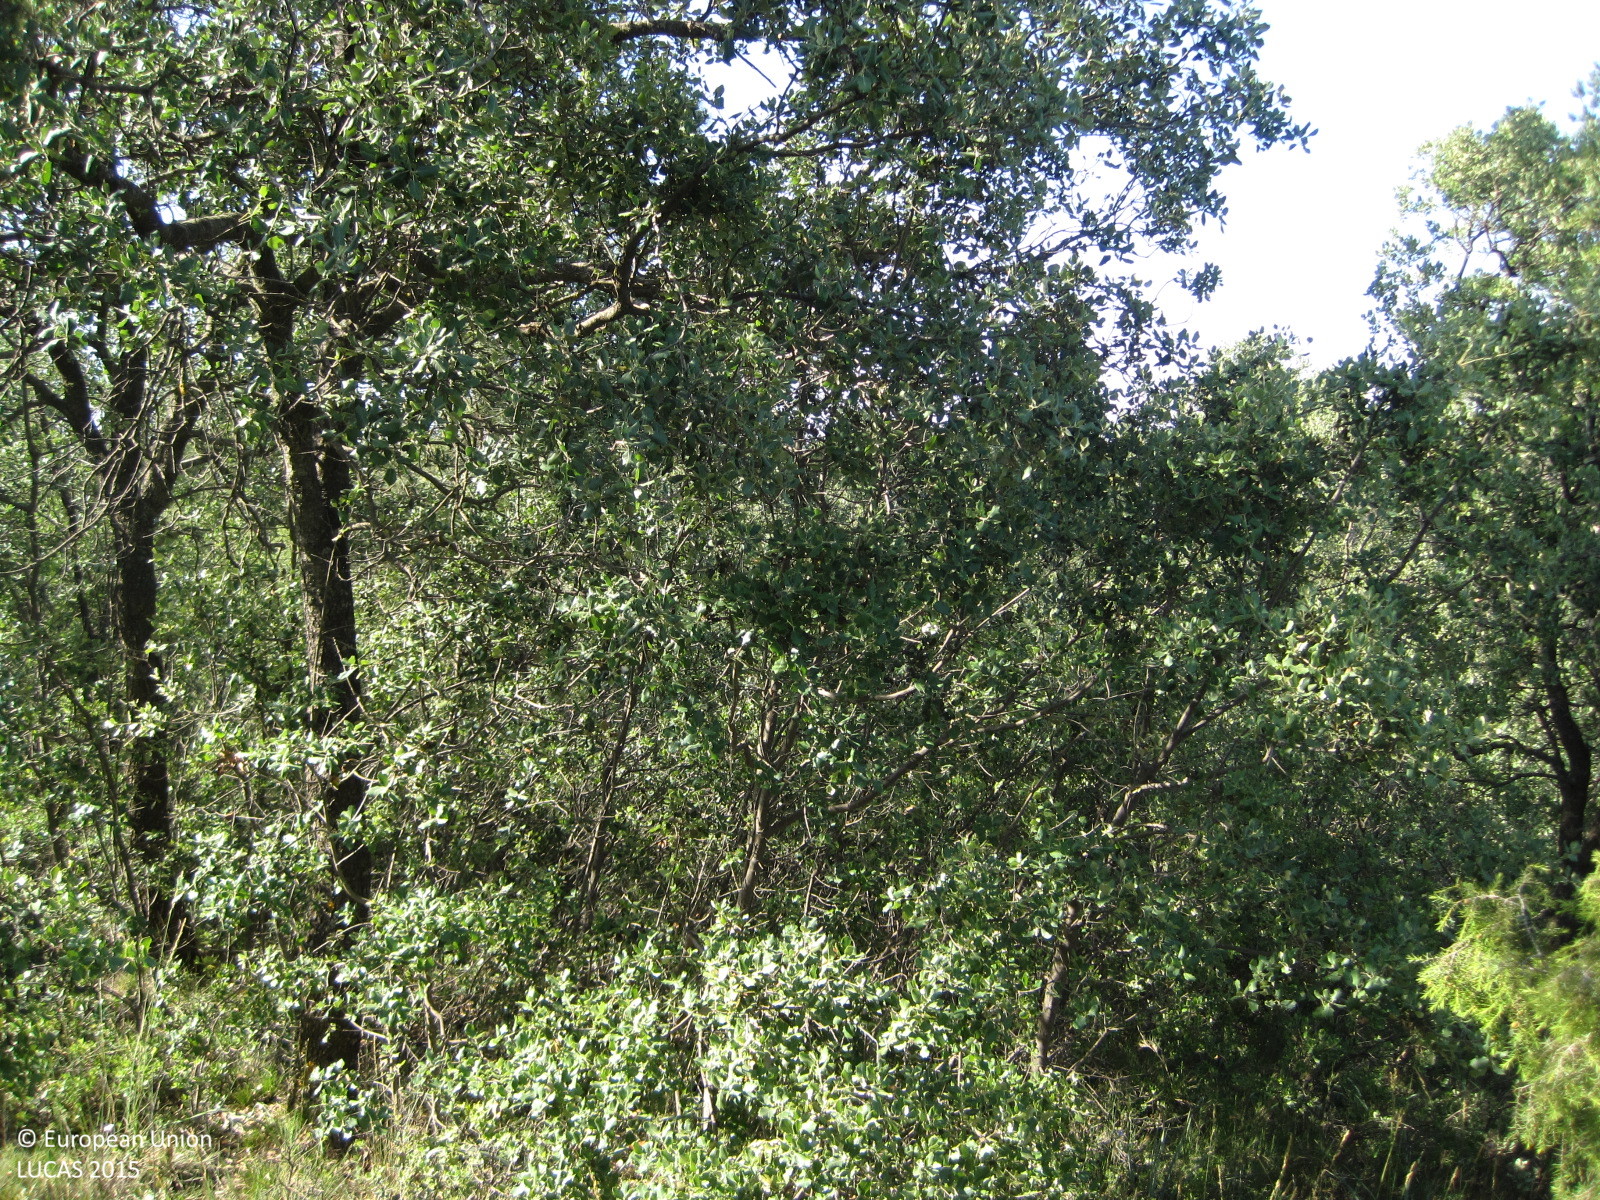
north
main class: Woodland
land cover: Broadleaved woodland
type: thermophilous deciduous forest
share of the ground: > 75 %
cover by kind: broadleaved forest trees 80 %, shrubs 15 %, coniferous forest trees 5 %
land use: Forestry
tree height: > 5 m
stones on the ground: 25 - 50 %
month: May
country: ES
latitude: 39.6320
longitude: -1.1298
